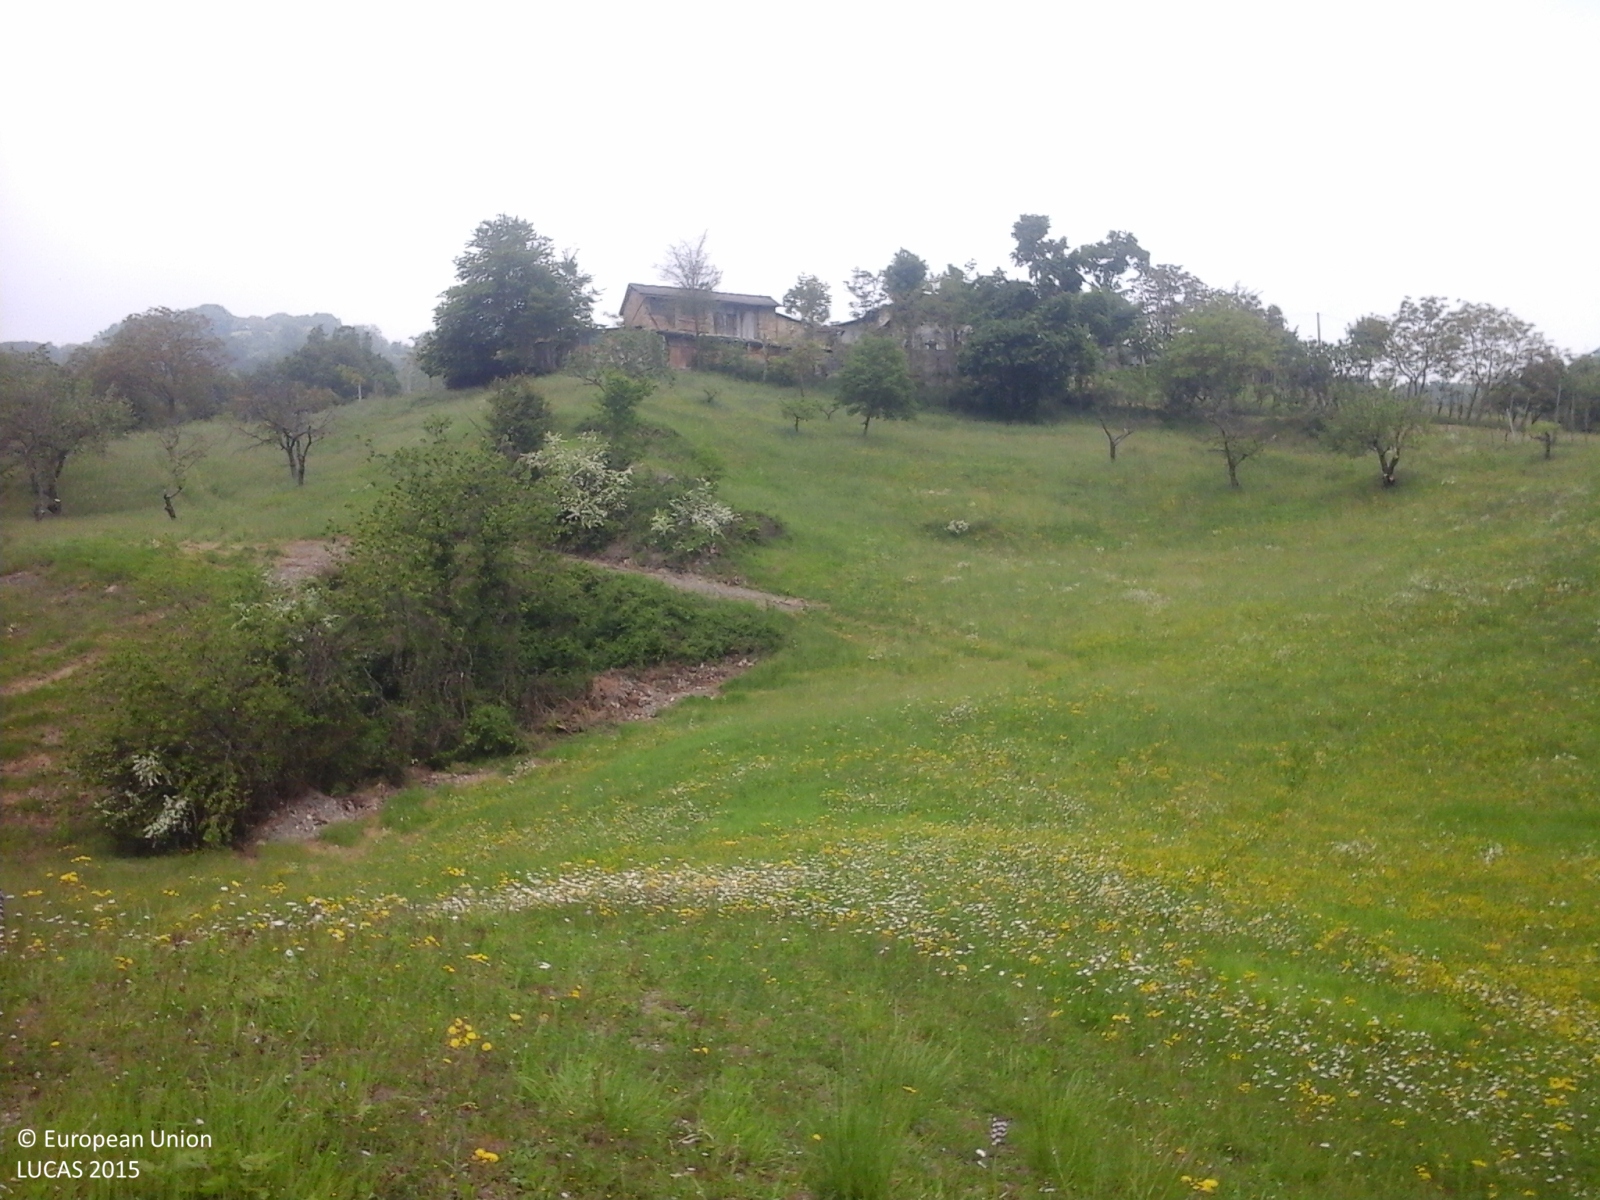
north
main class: Woodland
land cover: Broadleaved woodland
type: thermophilous deciduous forest
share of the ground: > 75 %
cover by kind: broadleaved forest trees 100 %
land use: Forestry
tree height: > 5 m
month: May
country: IT
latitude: 44.3634
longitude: 11.0391
